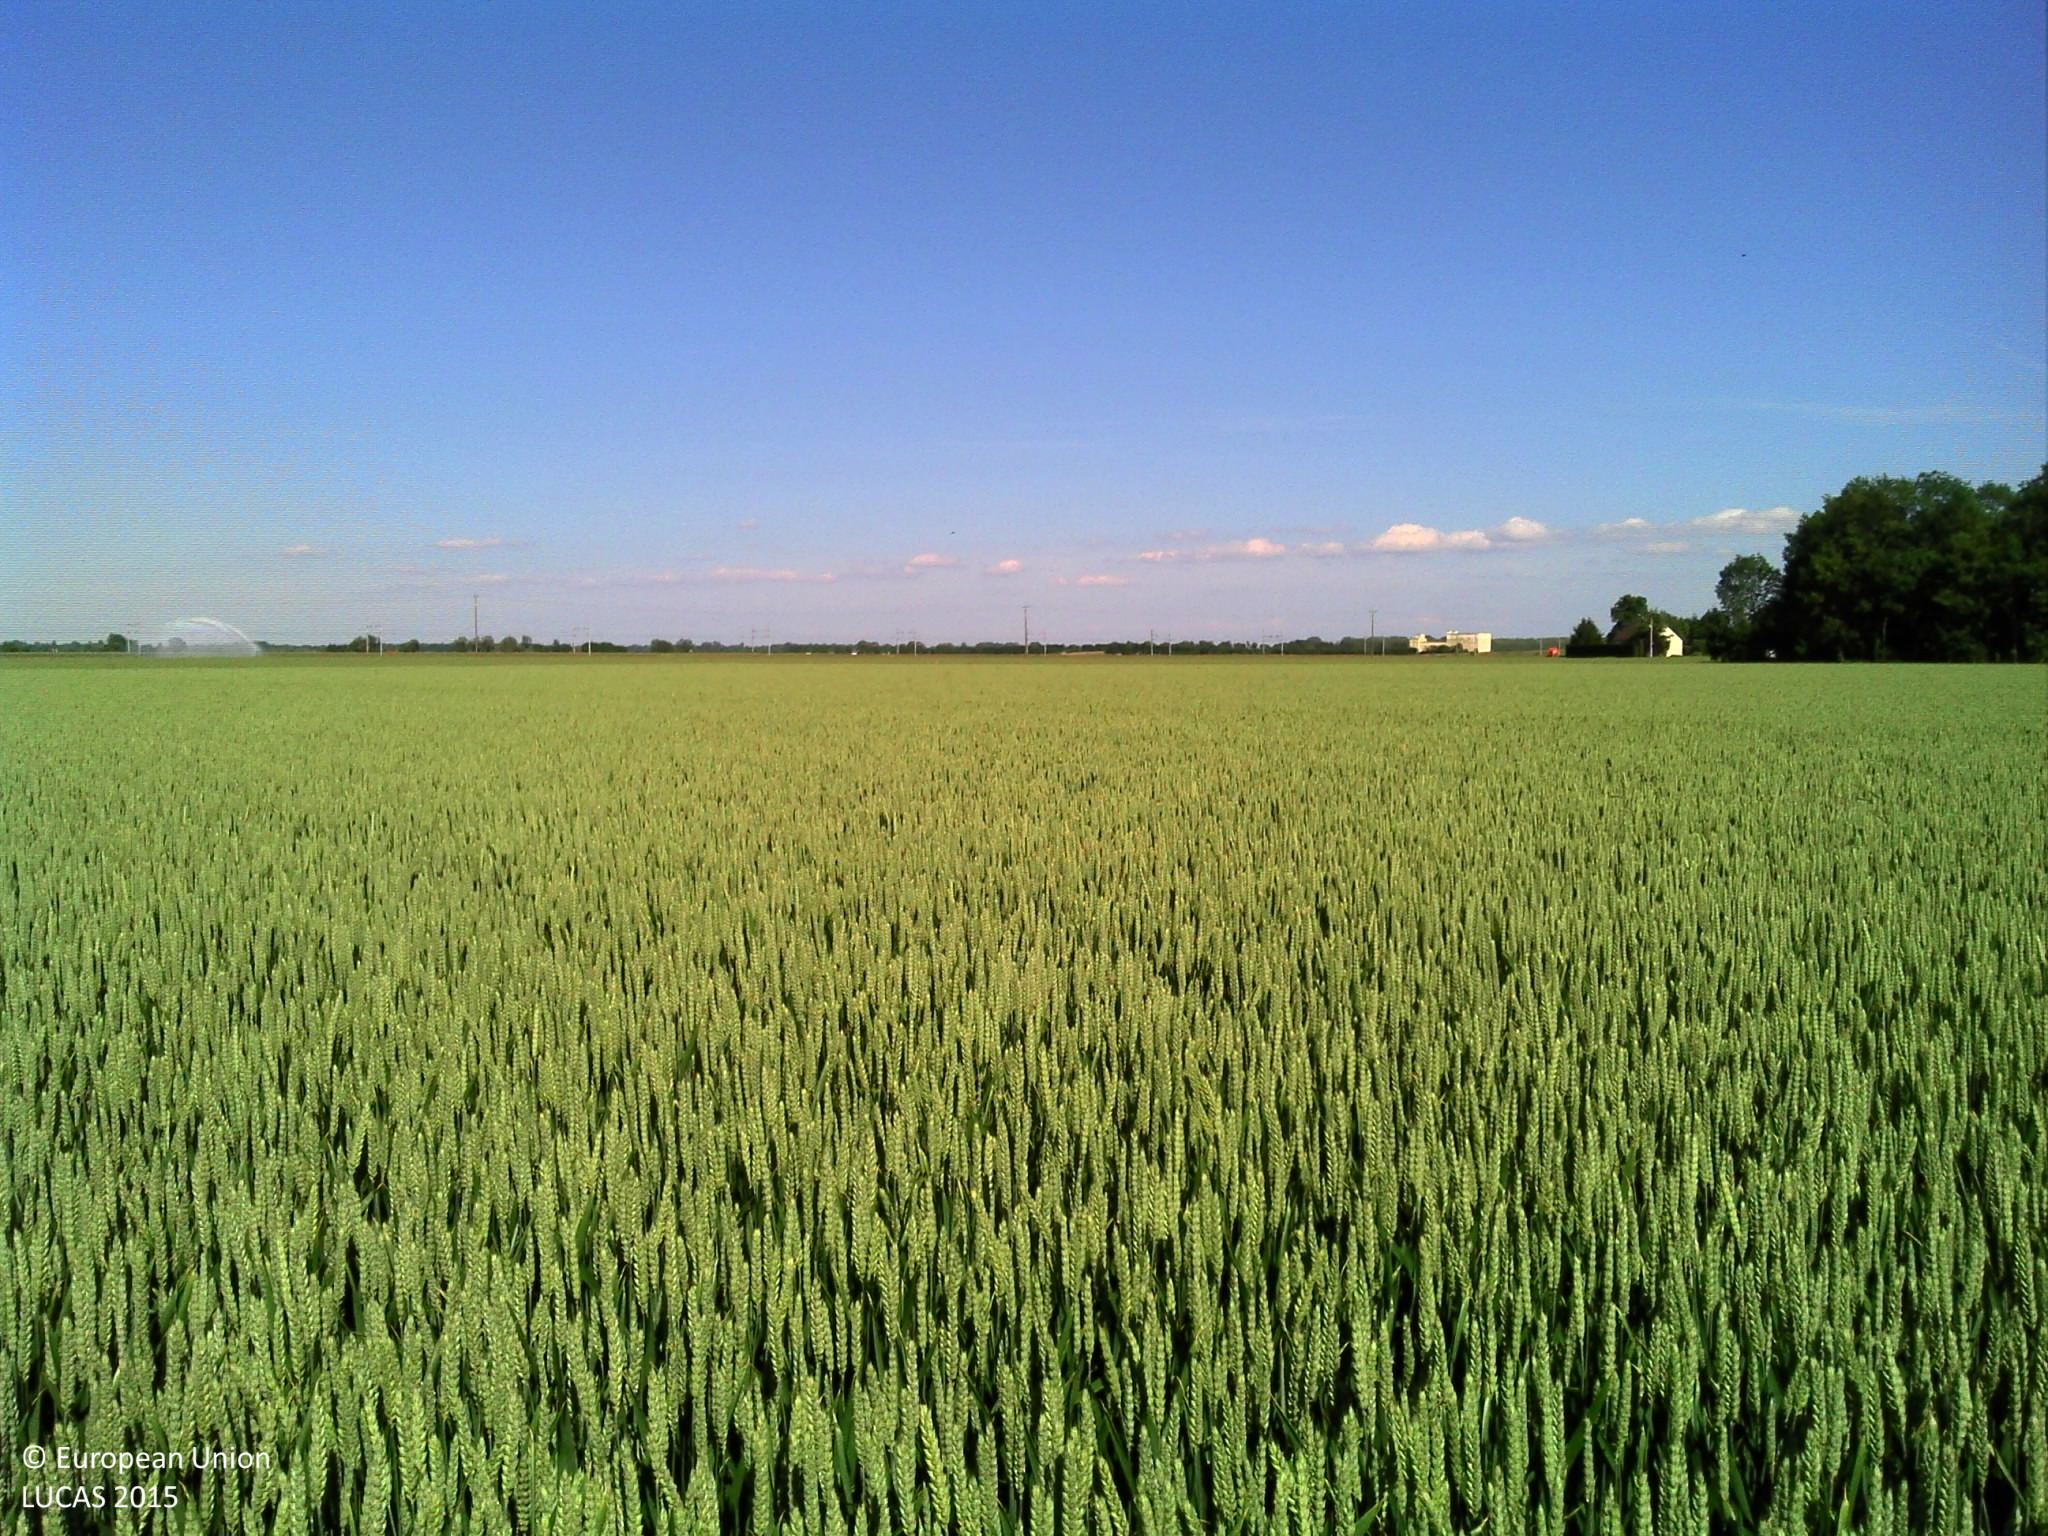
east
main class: Cropland
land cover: Common wheat
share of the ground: > 75 %
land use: Agriculture (excluding fallow land and kitchen gardens)
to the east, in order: Common wheat; Tracks; Ditches and canals; Tracks; Durum wheat
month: June
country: FR
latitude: 47.2479
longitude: 5.0725
